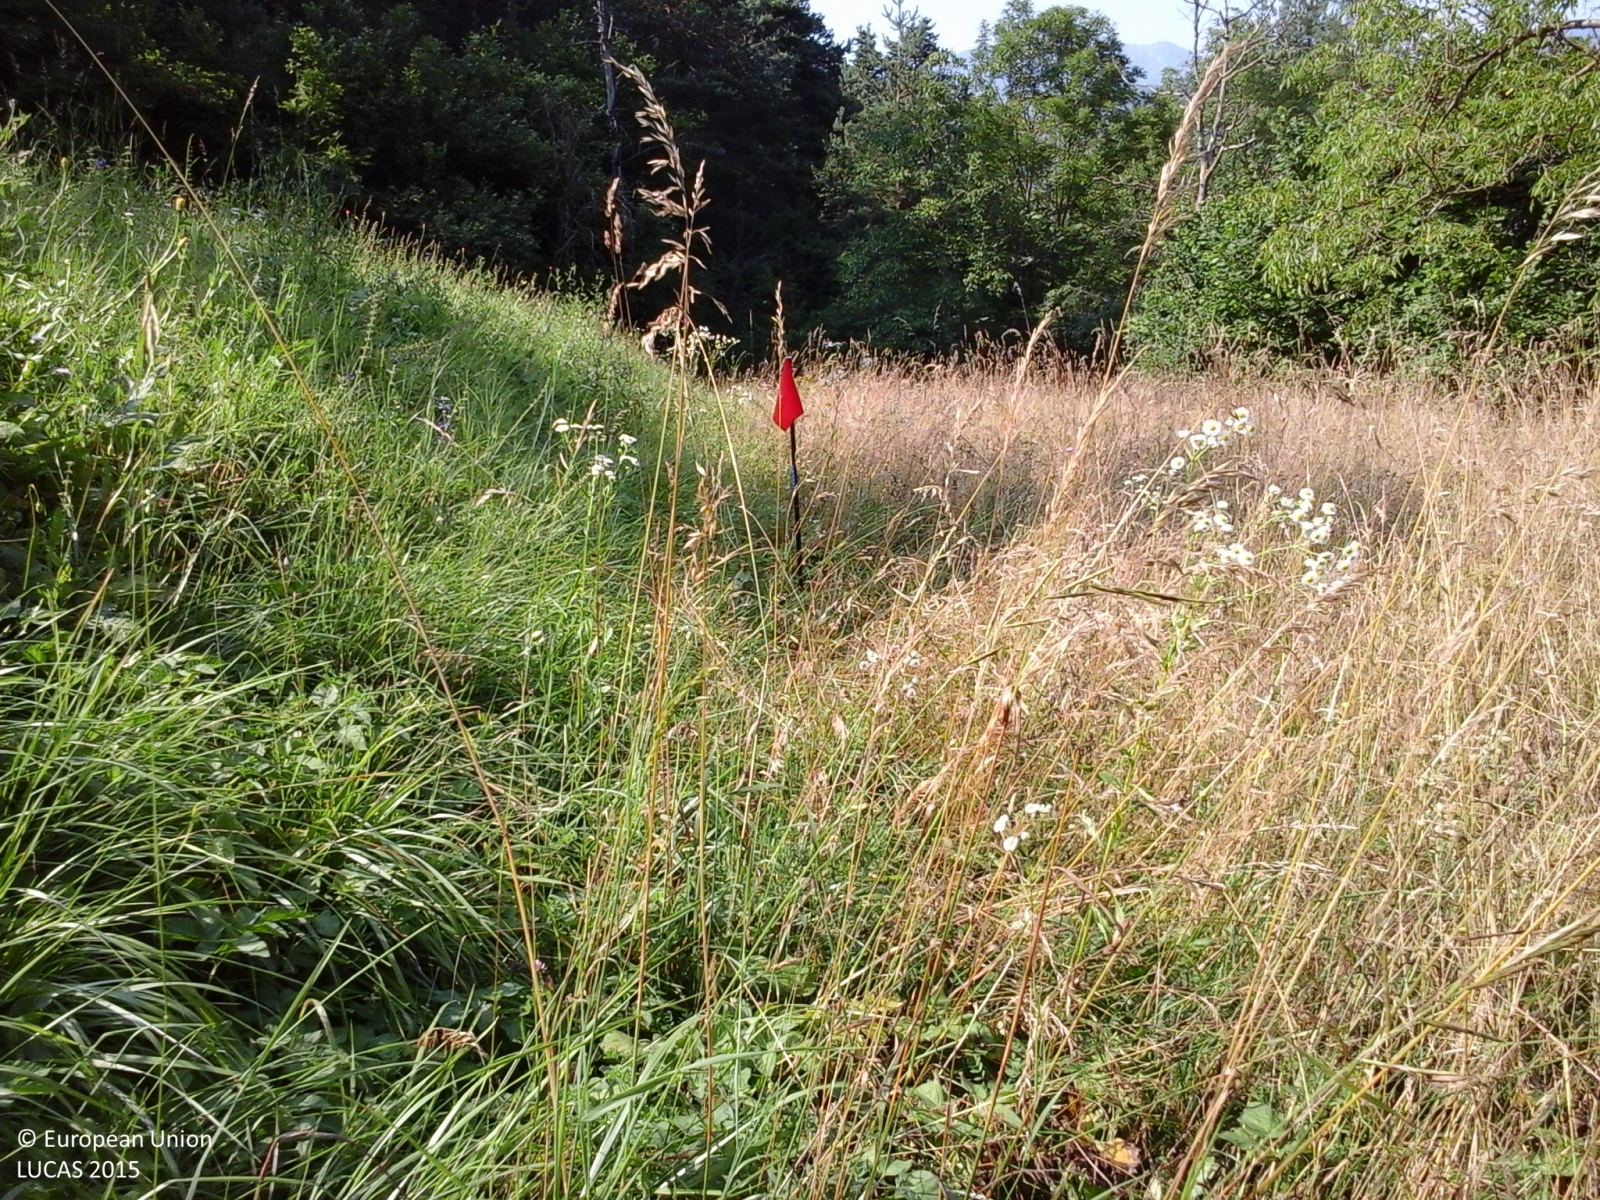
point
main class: Grassland
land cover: Grassland with sparse tree/shrub cover
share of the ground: > 75 %
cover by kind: herbaceous plants 95 %, broadleaved forest trees 5 %
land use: Agriculture (excluding fallow land and kitchen gardens)
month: July
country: IT
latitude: 44.4599
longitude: 7.3032
